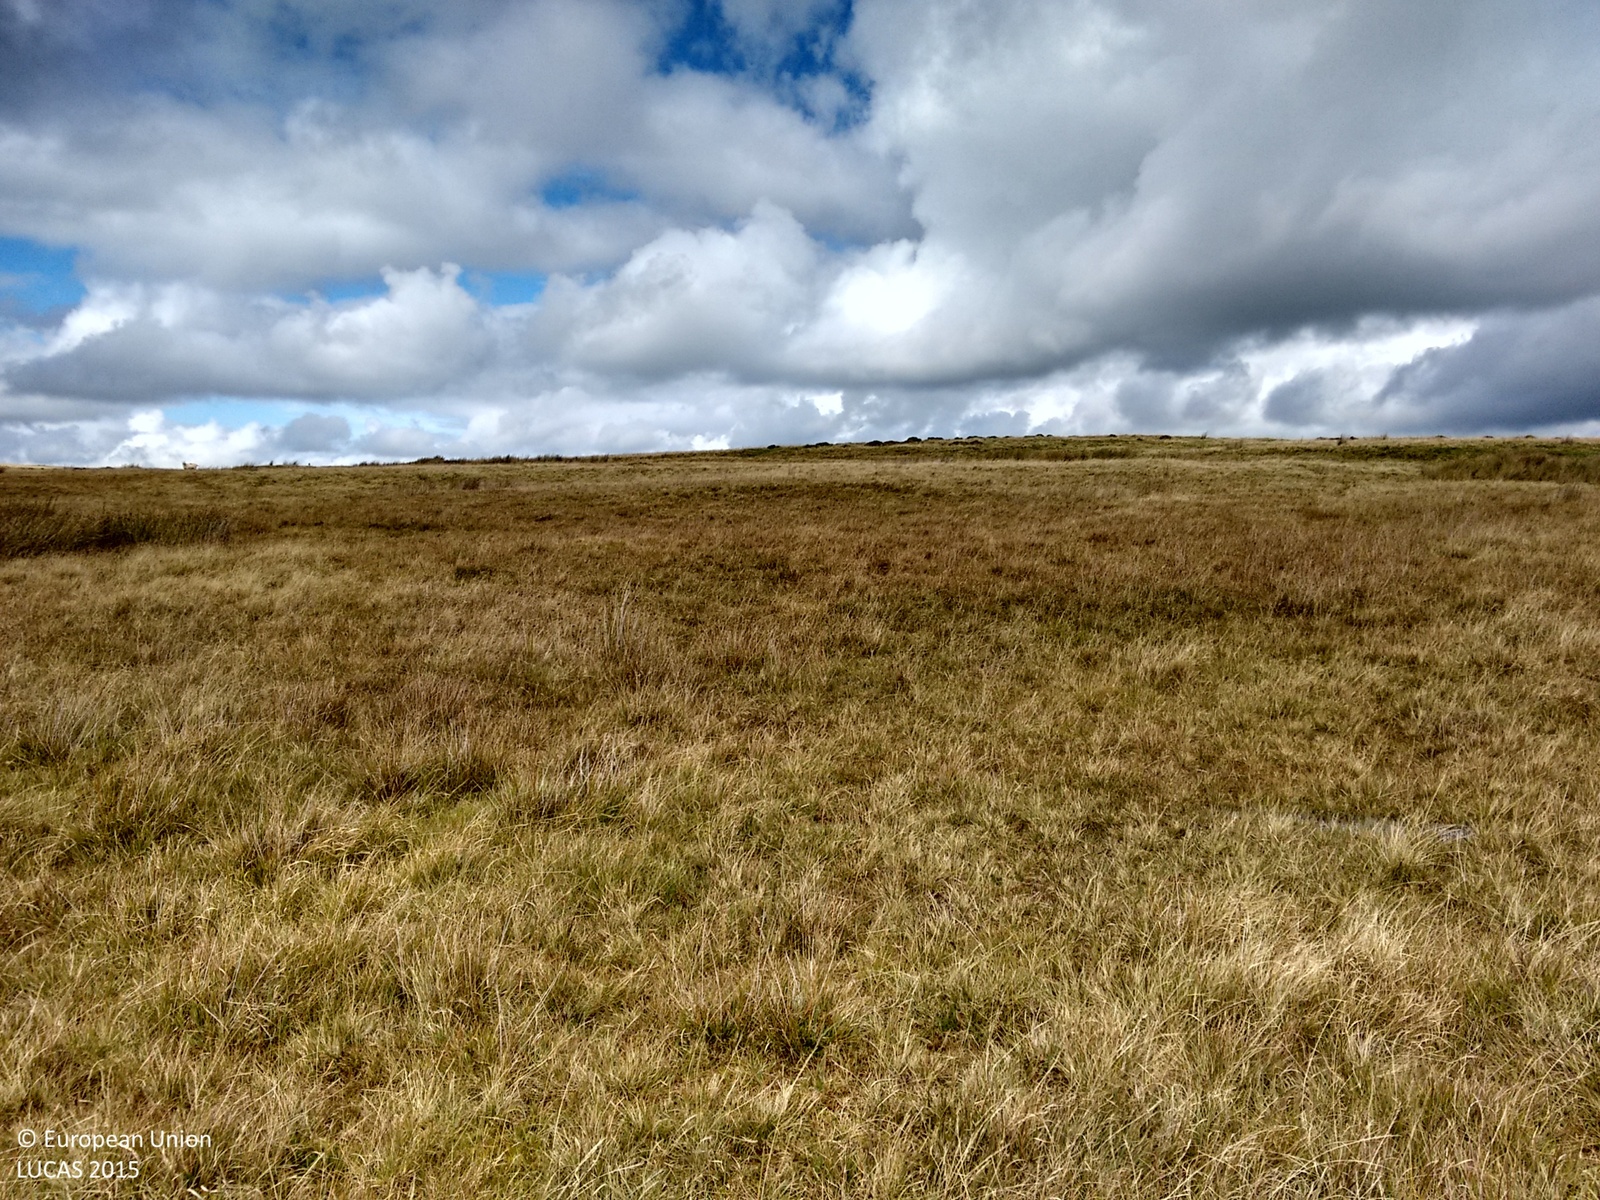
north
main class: Grassland
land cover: Grassland without tree/shrub cover
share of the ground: > 75 %
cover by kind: herbaceous plants 100 %
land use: Agriculture (excluding fallow land and kitchen gardens)
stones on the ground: < 10 %
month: September
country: GB
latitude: 51.9618
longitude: -3.6958
